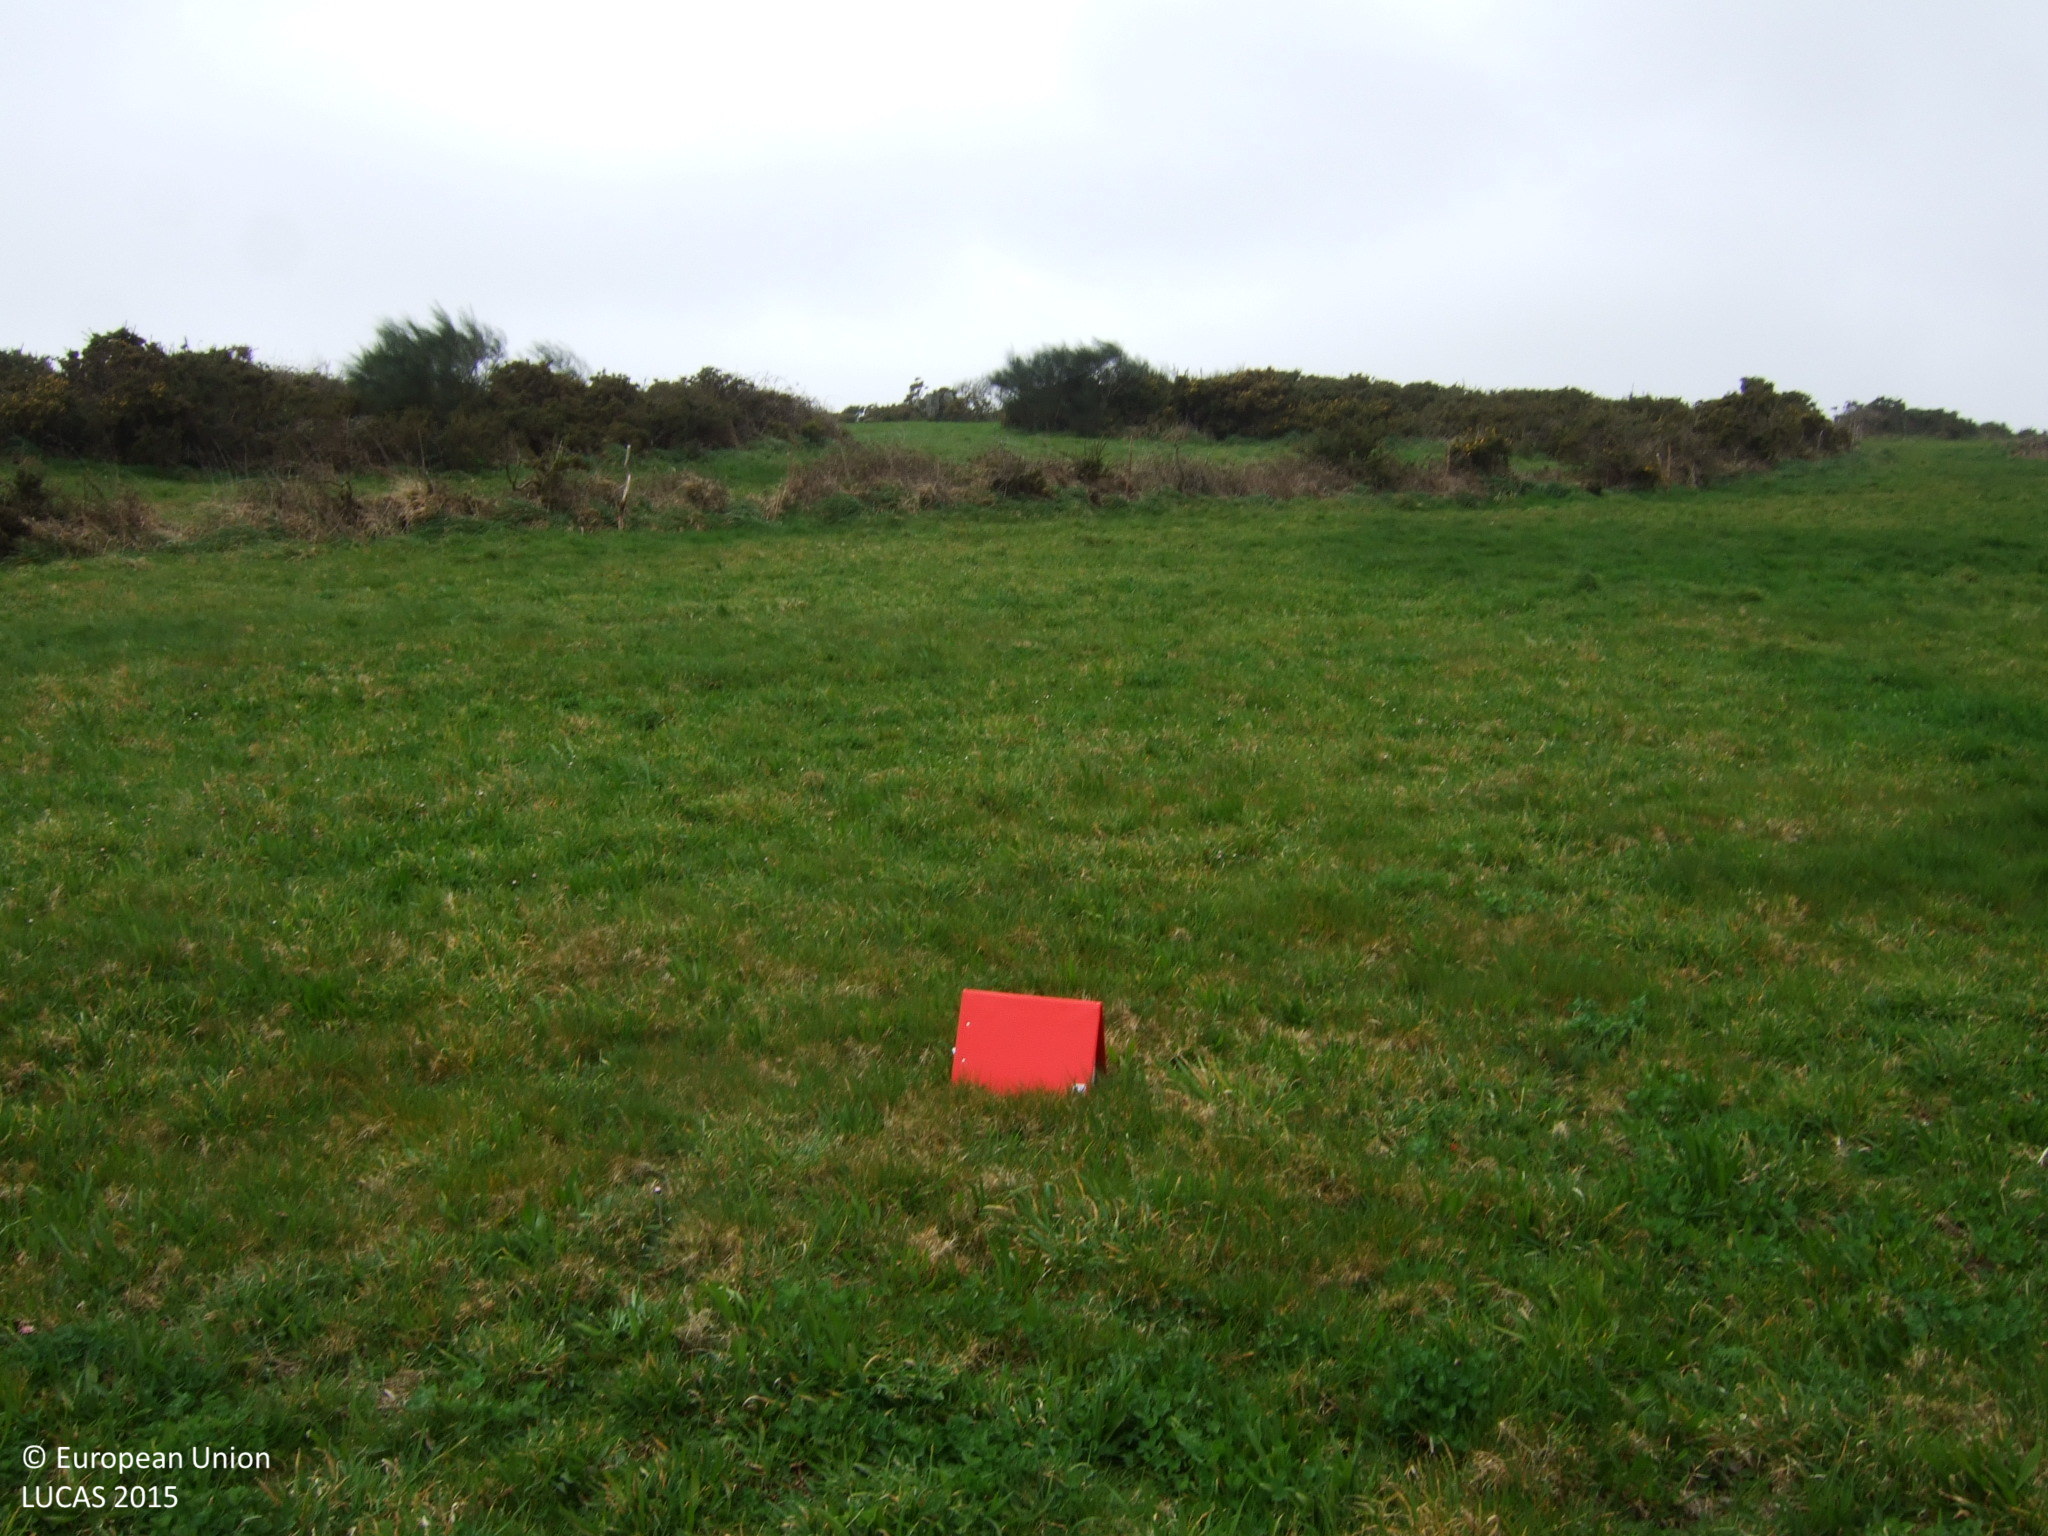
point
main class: Grassland
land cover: Grassland without tree/shrub cover
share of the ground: > 75 %
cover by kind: herbaceous plants 100 %
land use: Agriculture (excluding fallow land and kitchen gardens)
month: March
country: ES
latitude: 42.9540
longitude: -7.8460
